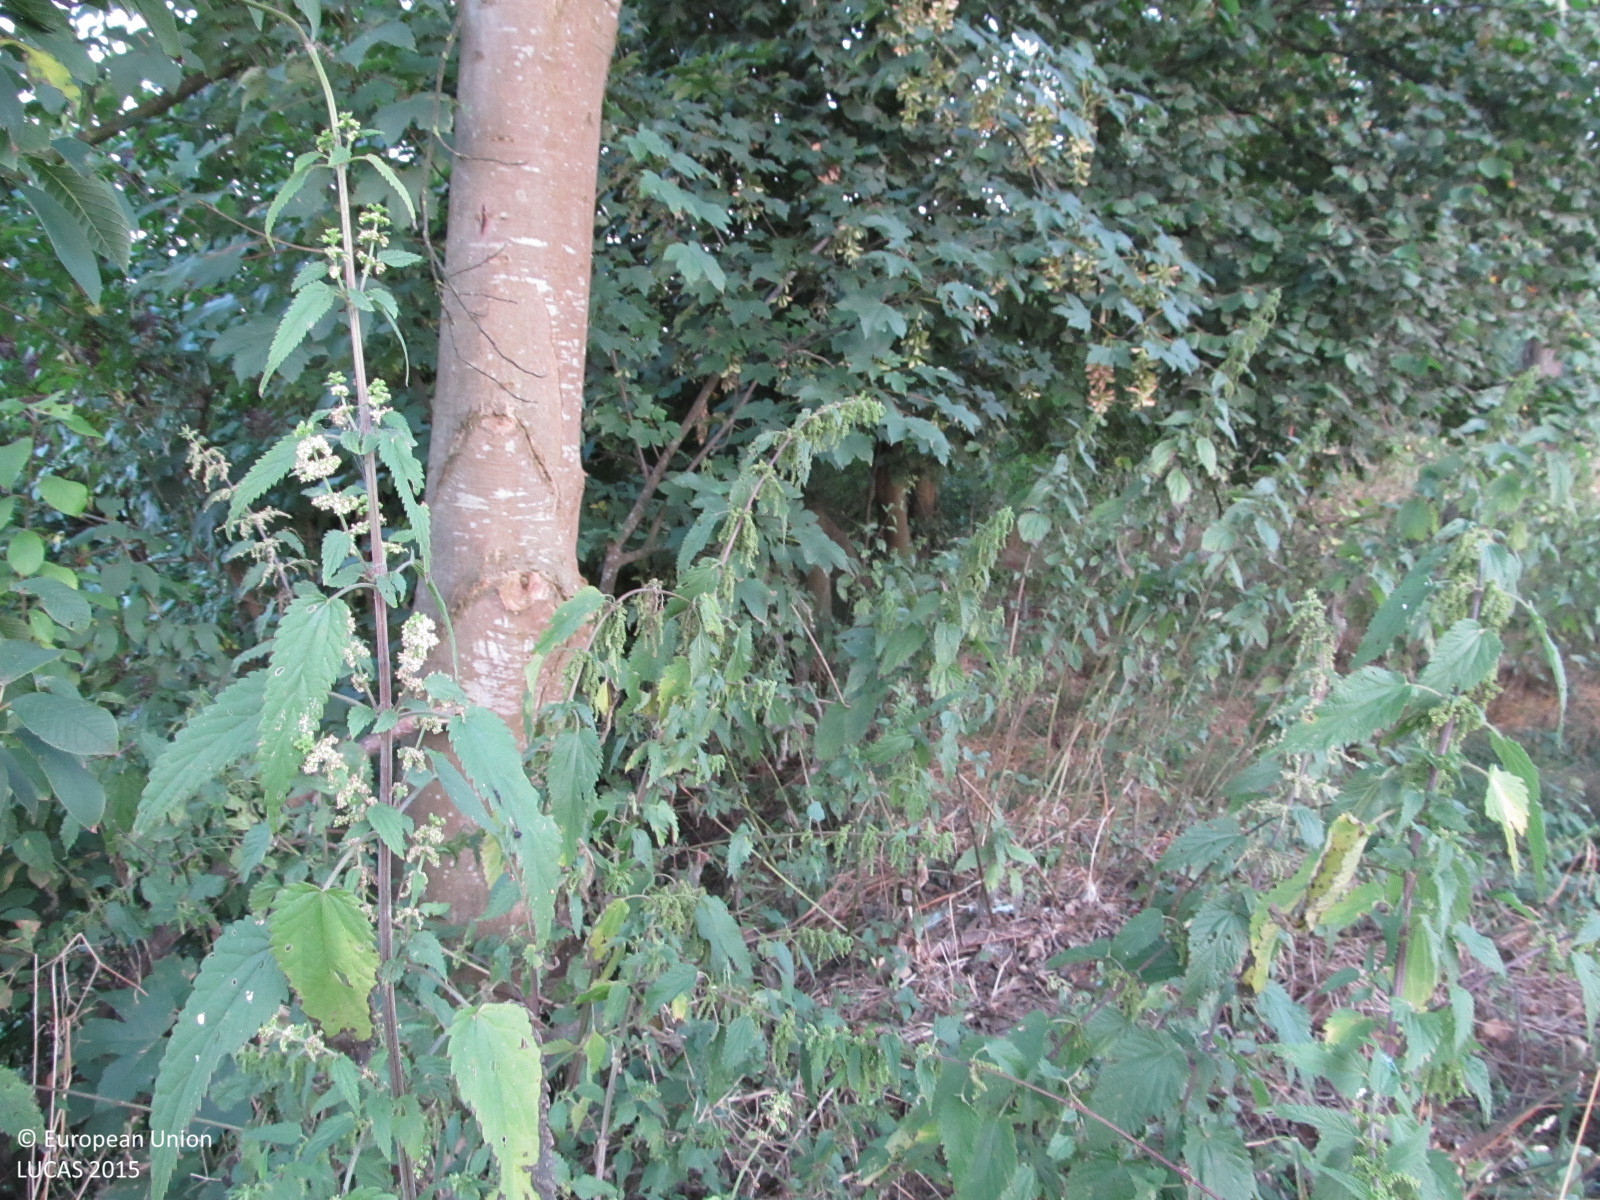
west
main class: Cropland
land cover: Common wheat
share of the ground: > 75 %
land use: Agriculture (excluding fallow land and kitchen gardens)
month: August
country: AT
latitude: 48.1736
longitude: 15.5563
